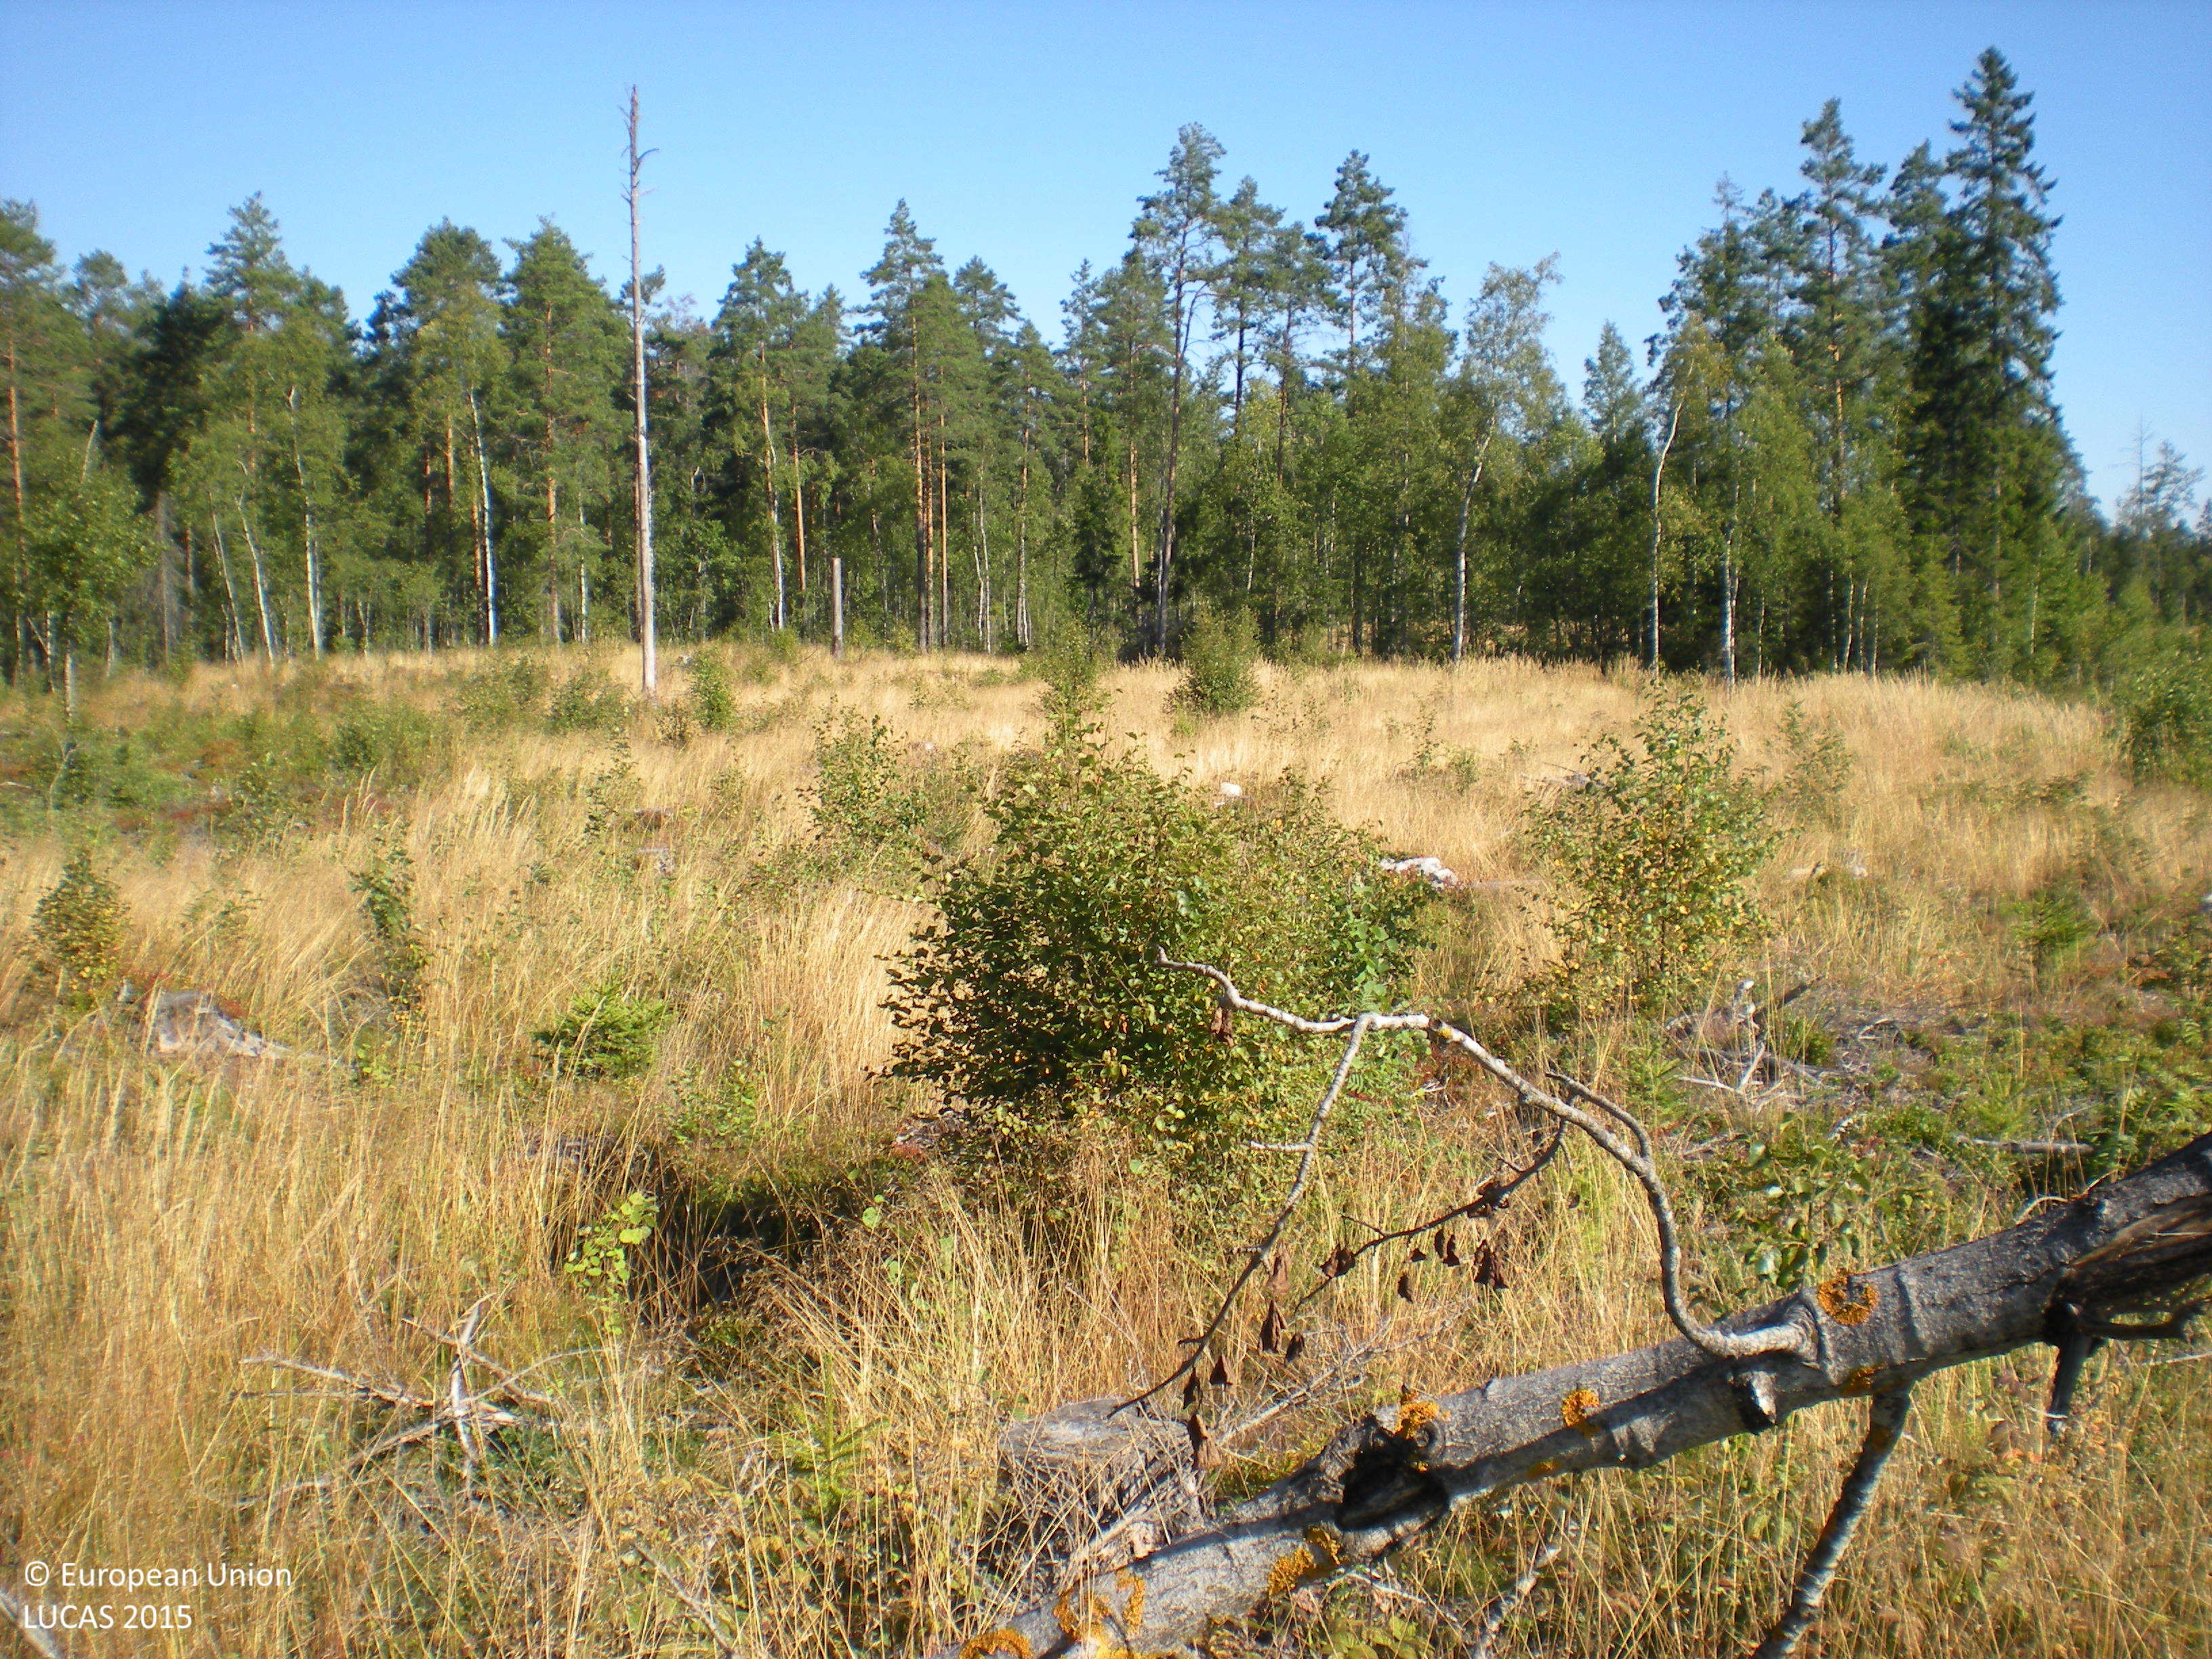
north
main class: Woodland
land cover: Broadleaved woodland
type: boreal forest
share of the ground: 10 - 25 %
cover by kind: herbaceous plants 50 %, broadleaved forest trees 25 %, shrubs 20 %, coniferous forest trees 5 %
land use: Forestry
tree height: < 5 m
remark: Clear cut
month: August
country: SE
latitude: 60.6096
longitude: 17.2417
